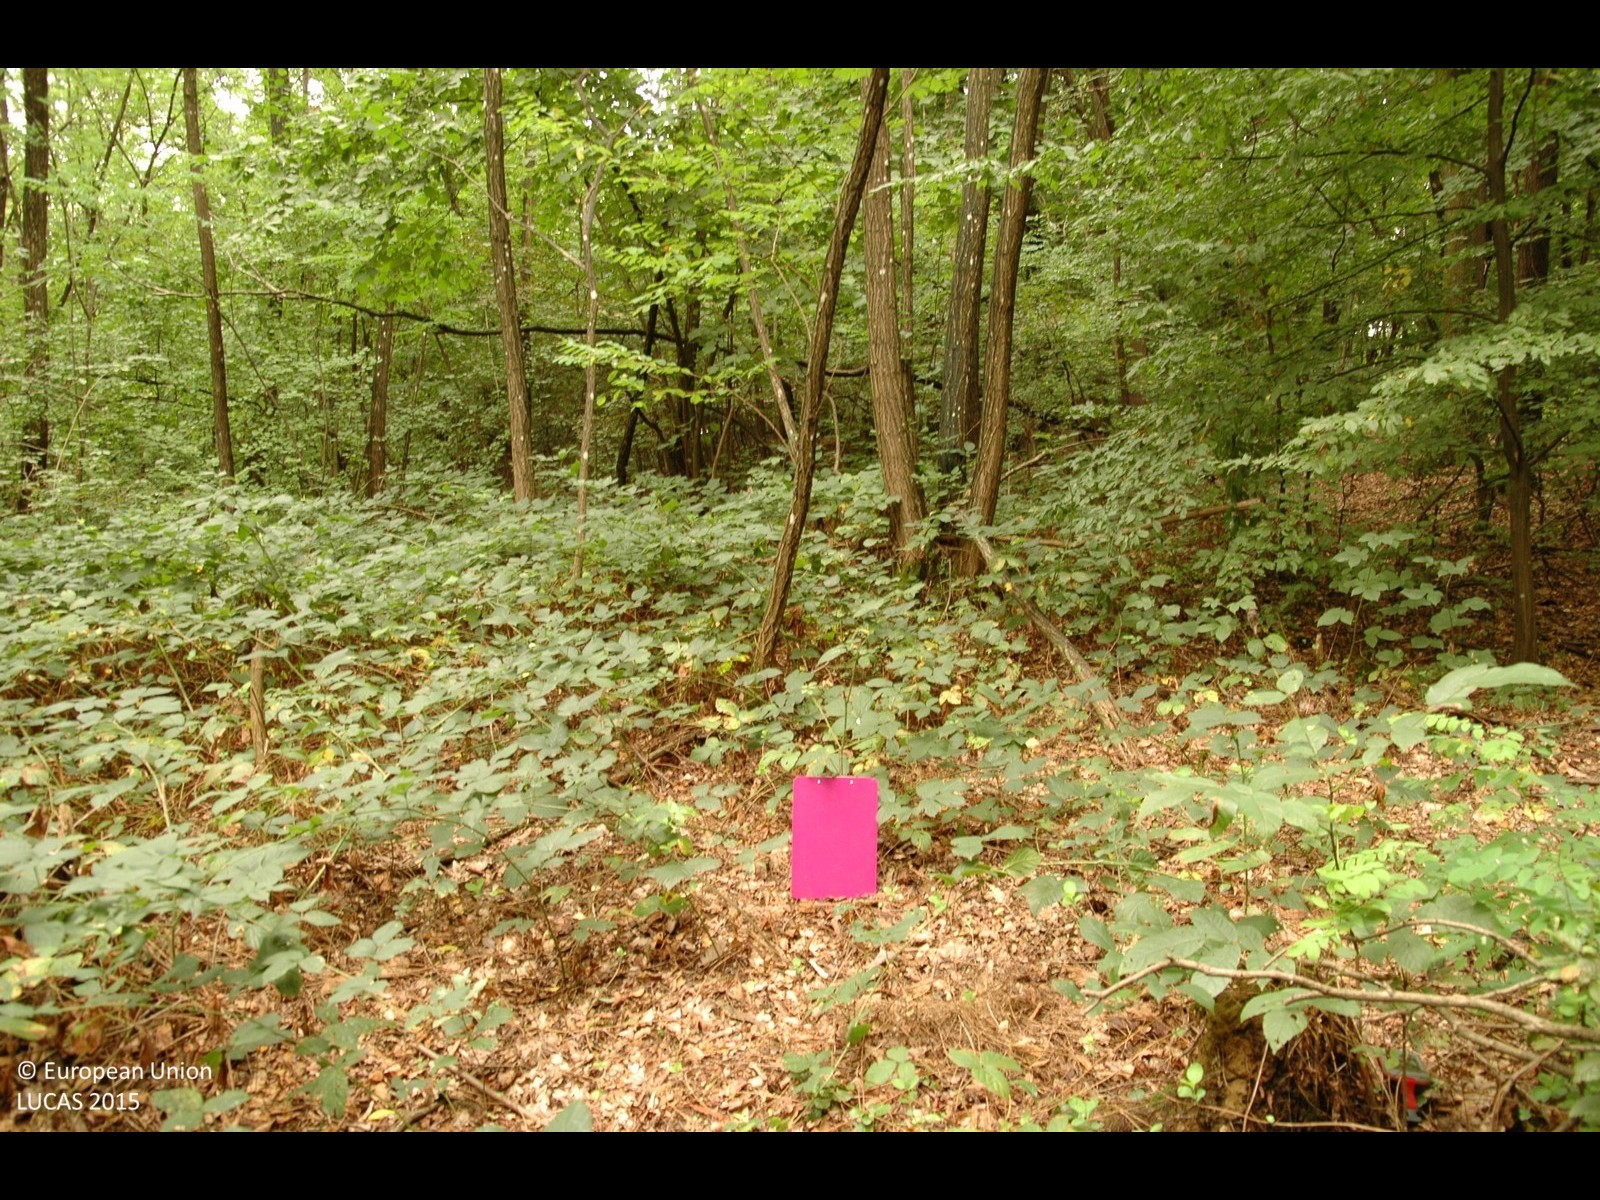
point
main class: Woodland
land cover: Broadleaved woodland
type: mesophytic deciduous forest
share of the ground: > 75 %
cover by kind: broadleaved forest trees 100 %
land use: Forestry
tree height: > 5 m
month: August
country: HR
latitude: 45.8690
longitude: 16.1173
